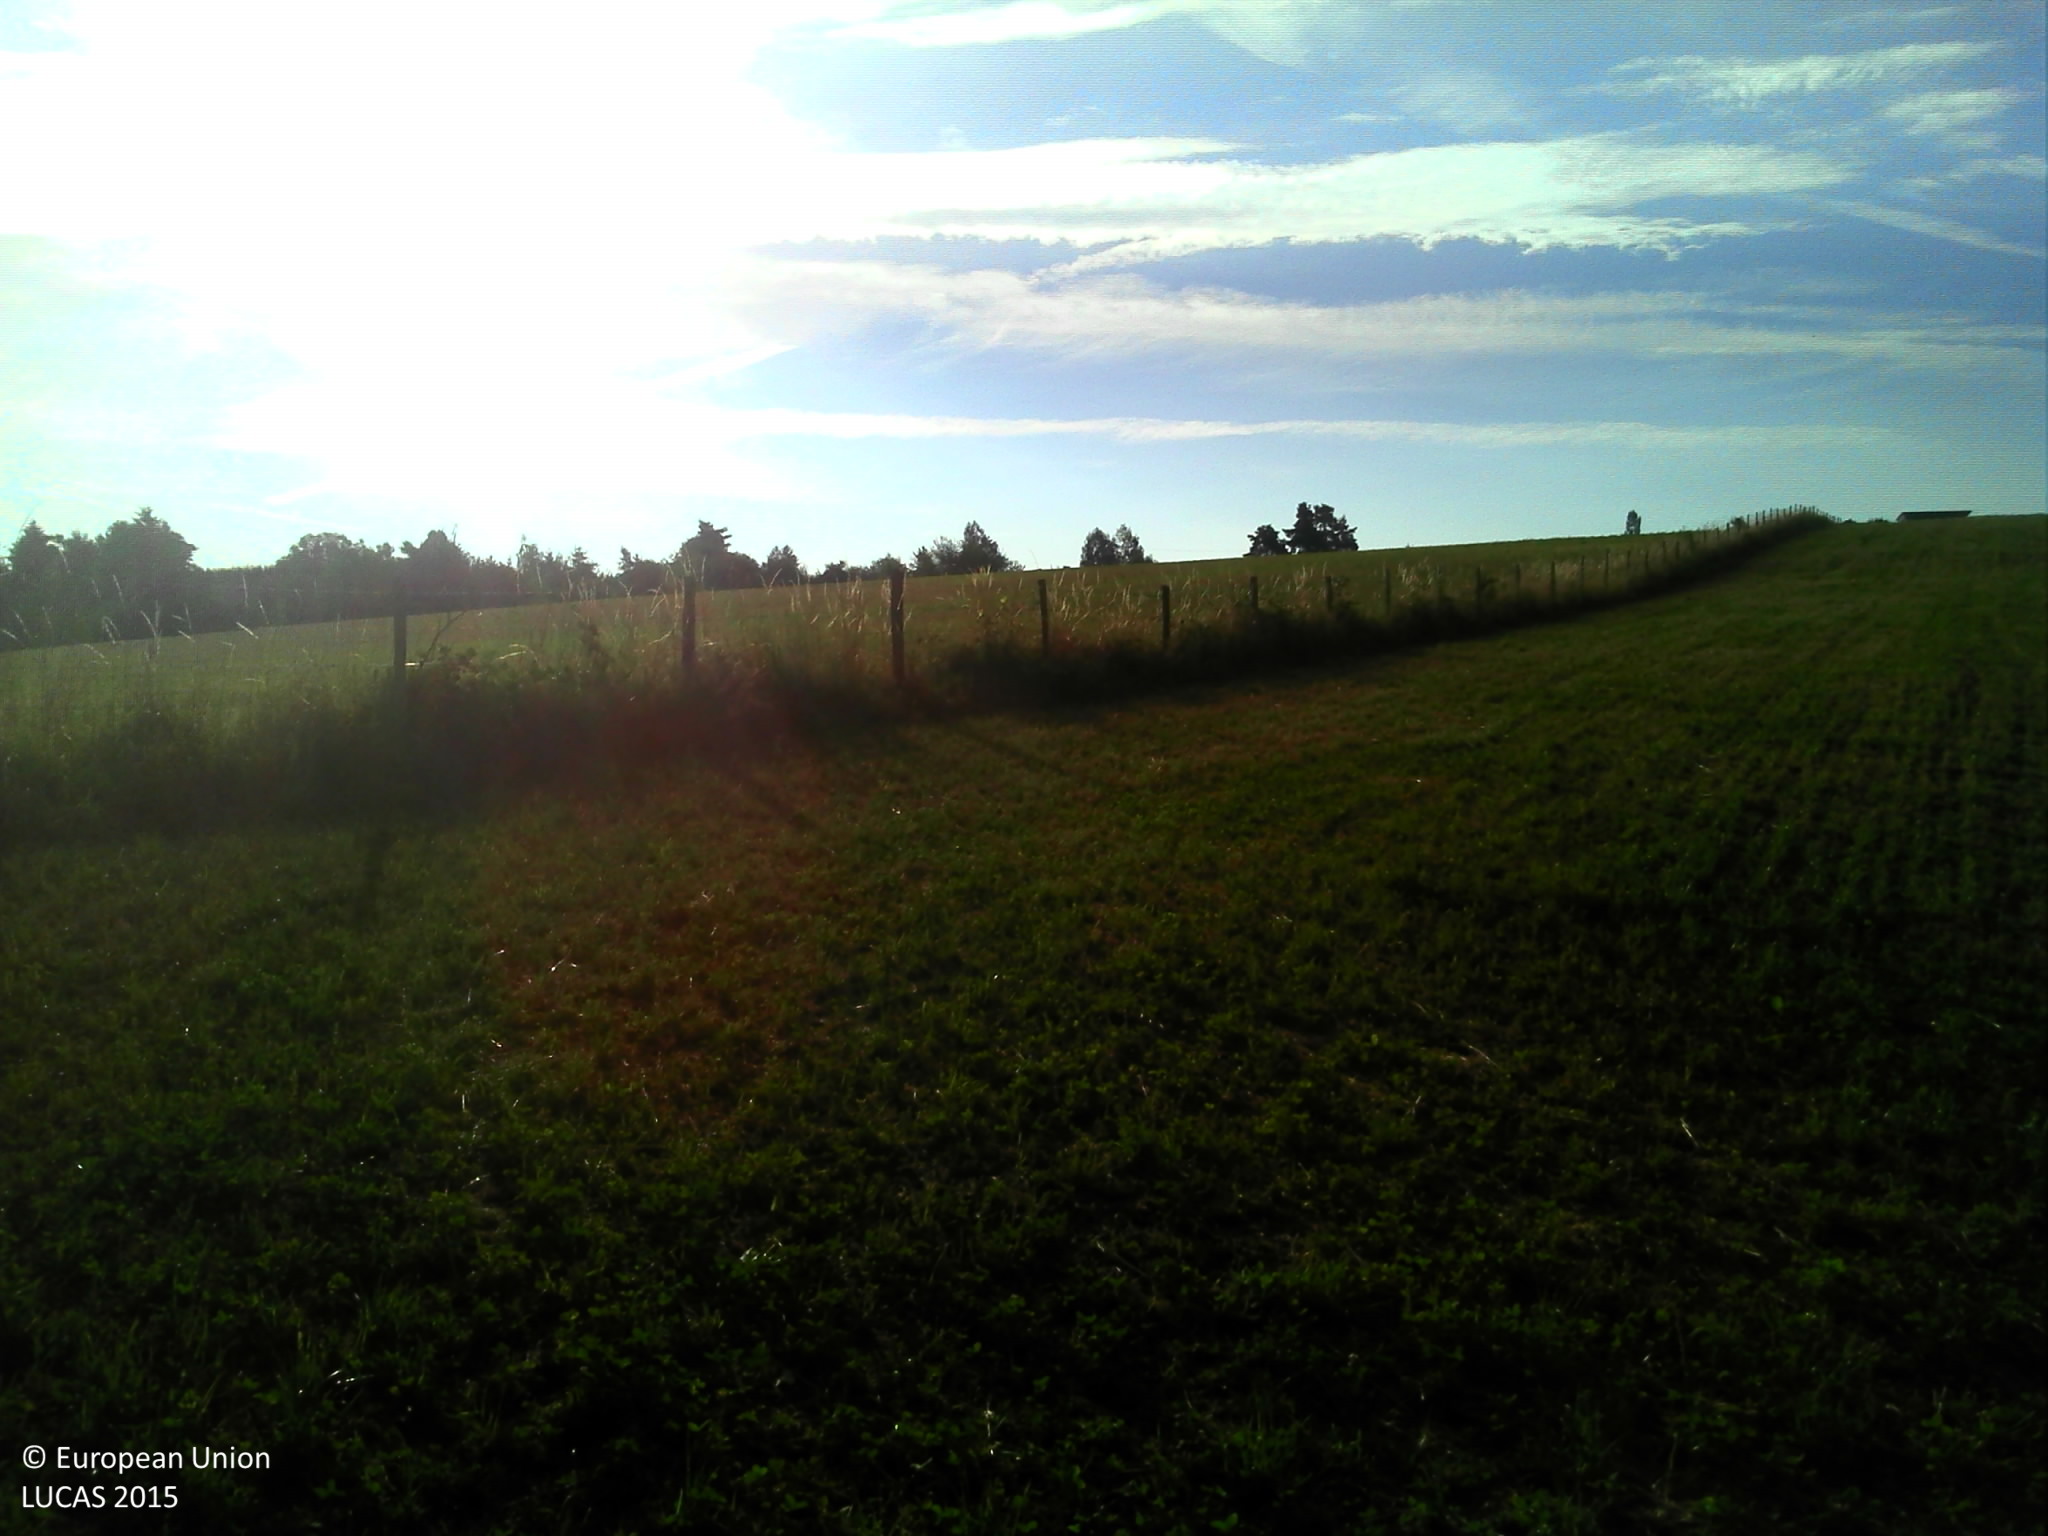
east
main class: Woodland
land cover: Pine dominated mixed woodland
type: exotic forest
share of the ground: > 75 %
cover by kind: broadleaved forest trees 50 %, coniferous forest trees 30 %, herbaceous plants 20 %
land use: Forestry
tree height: > 5 m
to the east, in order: Pine dominated mixed woodland; Fences; Temporary grasslands; Fences; Temporary grasslands
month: July
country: FR
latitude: 45.2701
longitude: 4.1536
